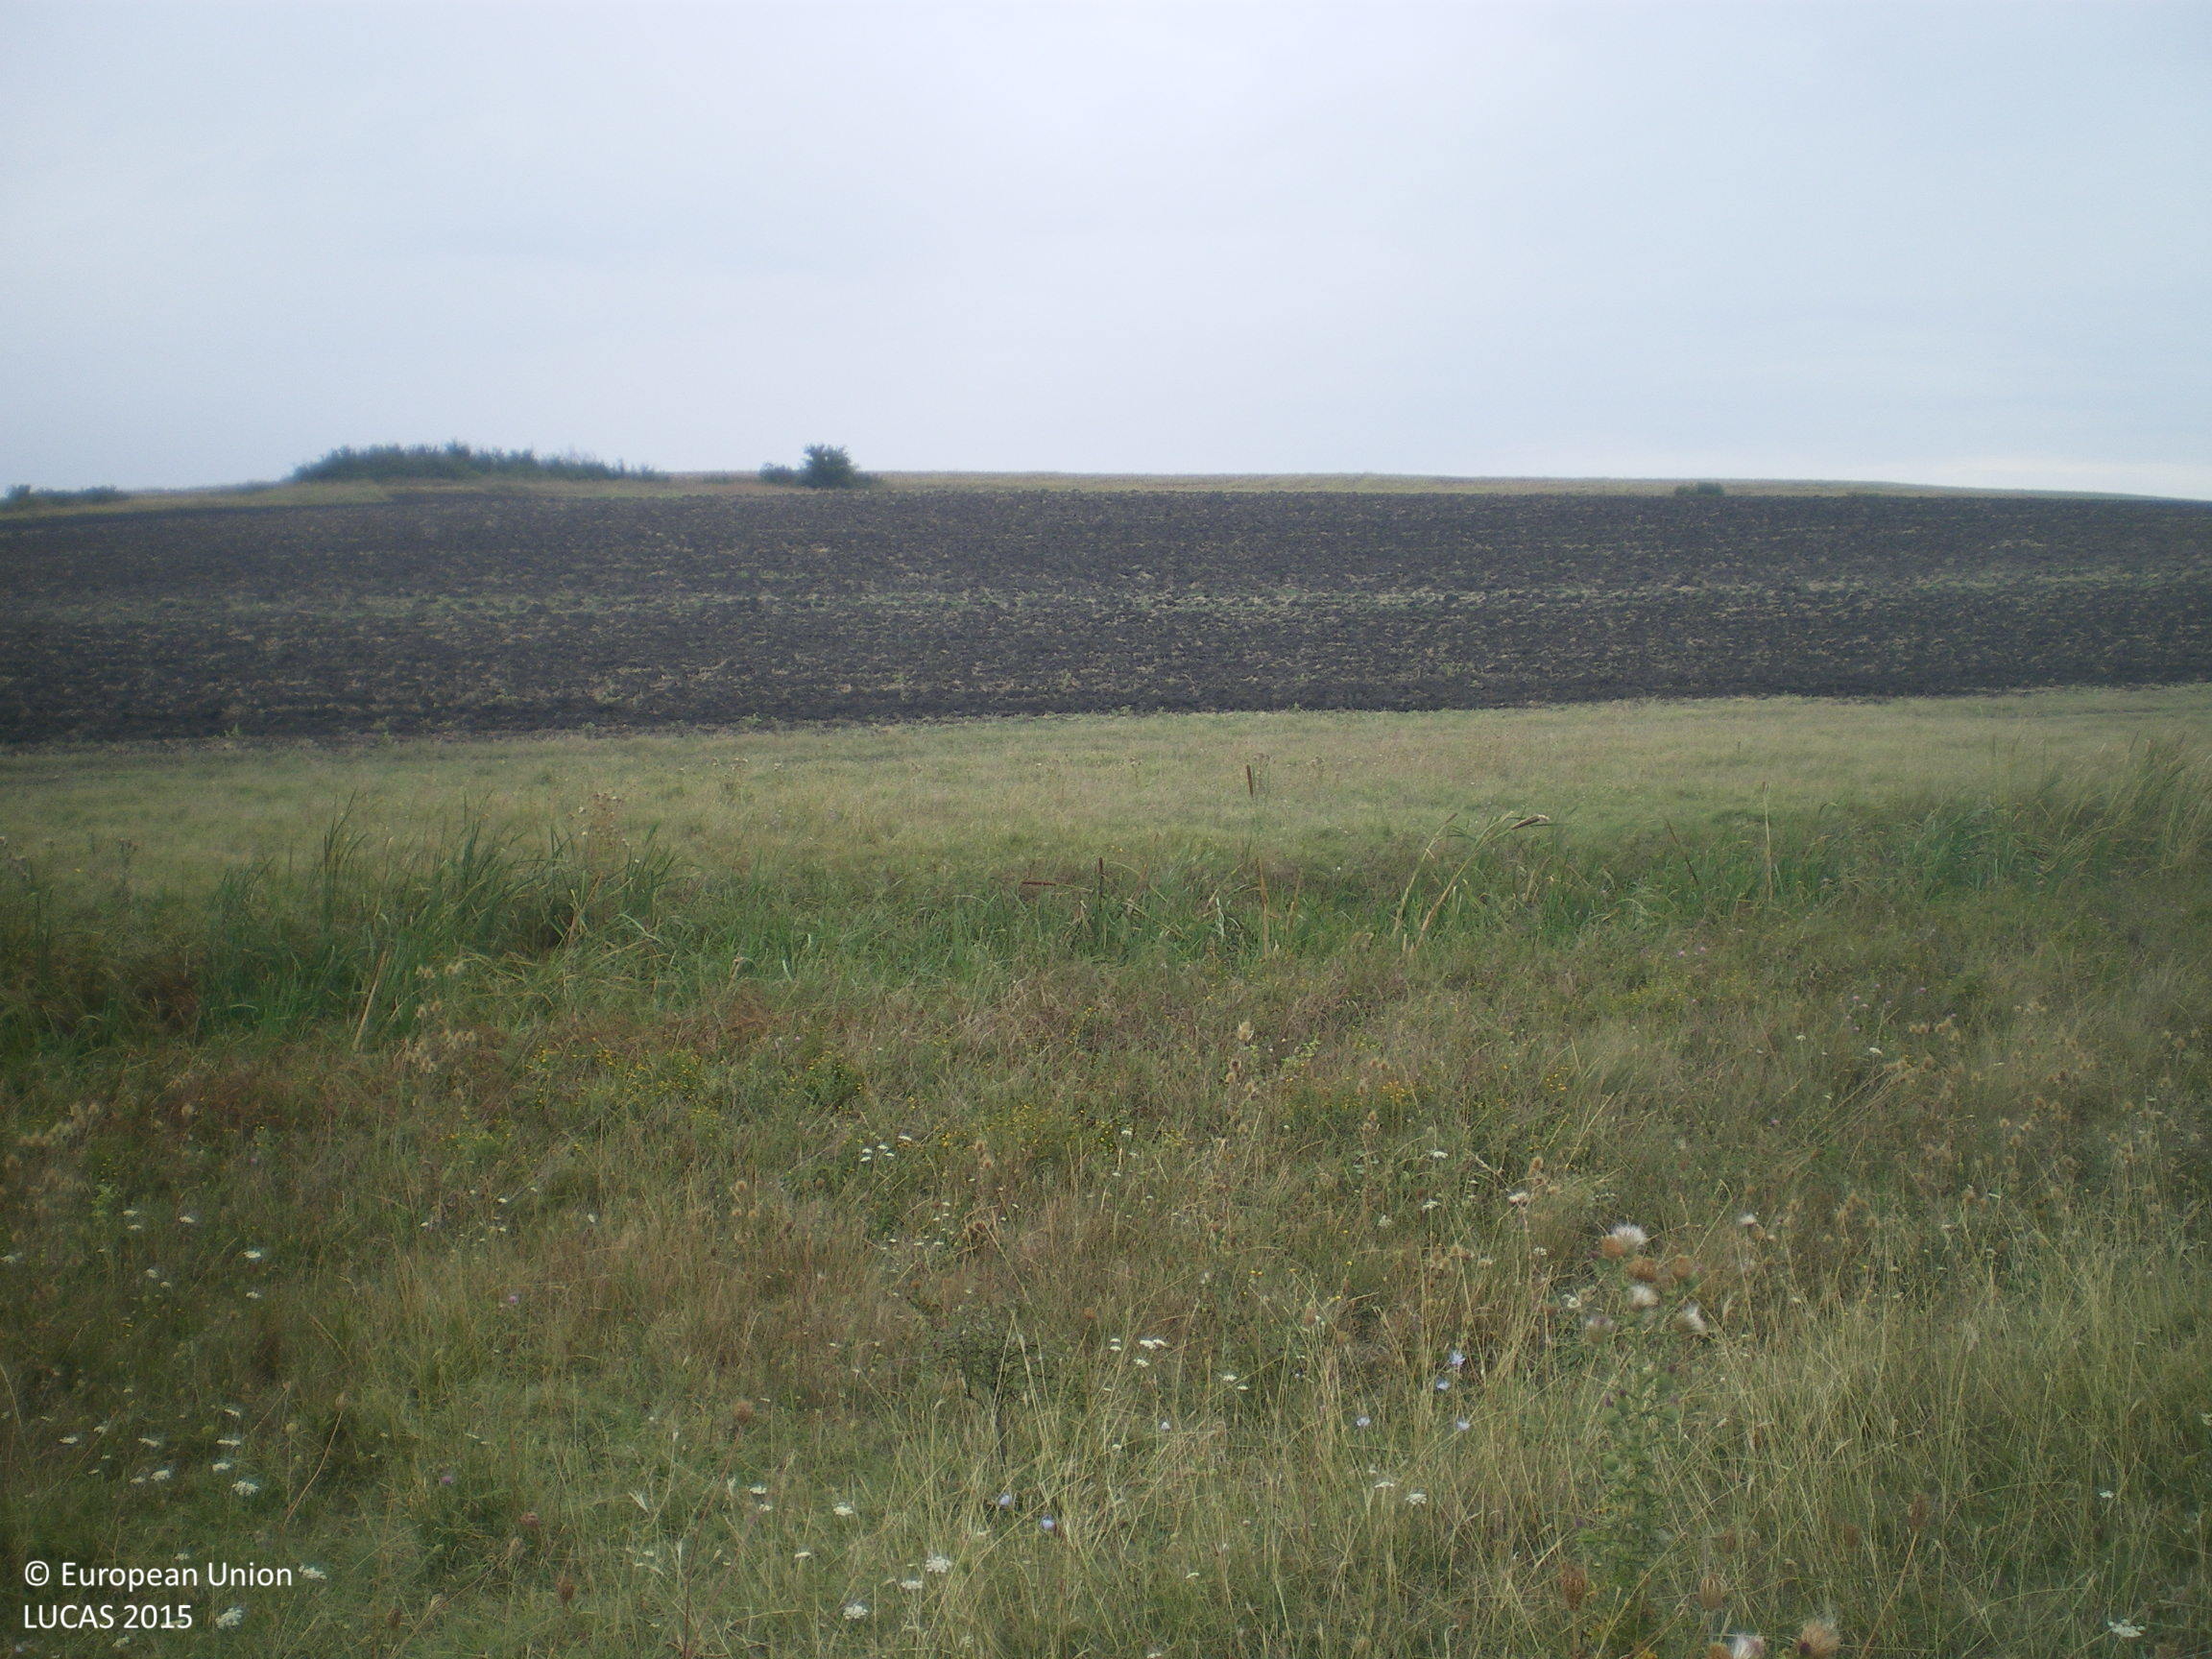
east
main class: Grassland
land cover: Grassland without tree/shrub cover
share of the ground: > 75 %
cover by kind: herbaceous plants 100 %
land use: Agriculture (excluding fallow land and kitchen gardens)
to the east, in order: Grassland without tree/shrub cover; Rivers and streams; Grassland without tree/shrub cover; Tracks; Grass margins; Rye
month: September
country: BG
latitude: 42.2356
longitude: 25.8885
